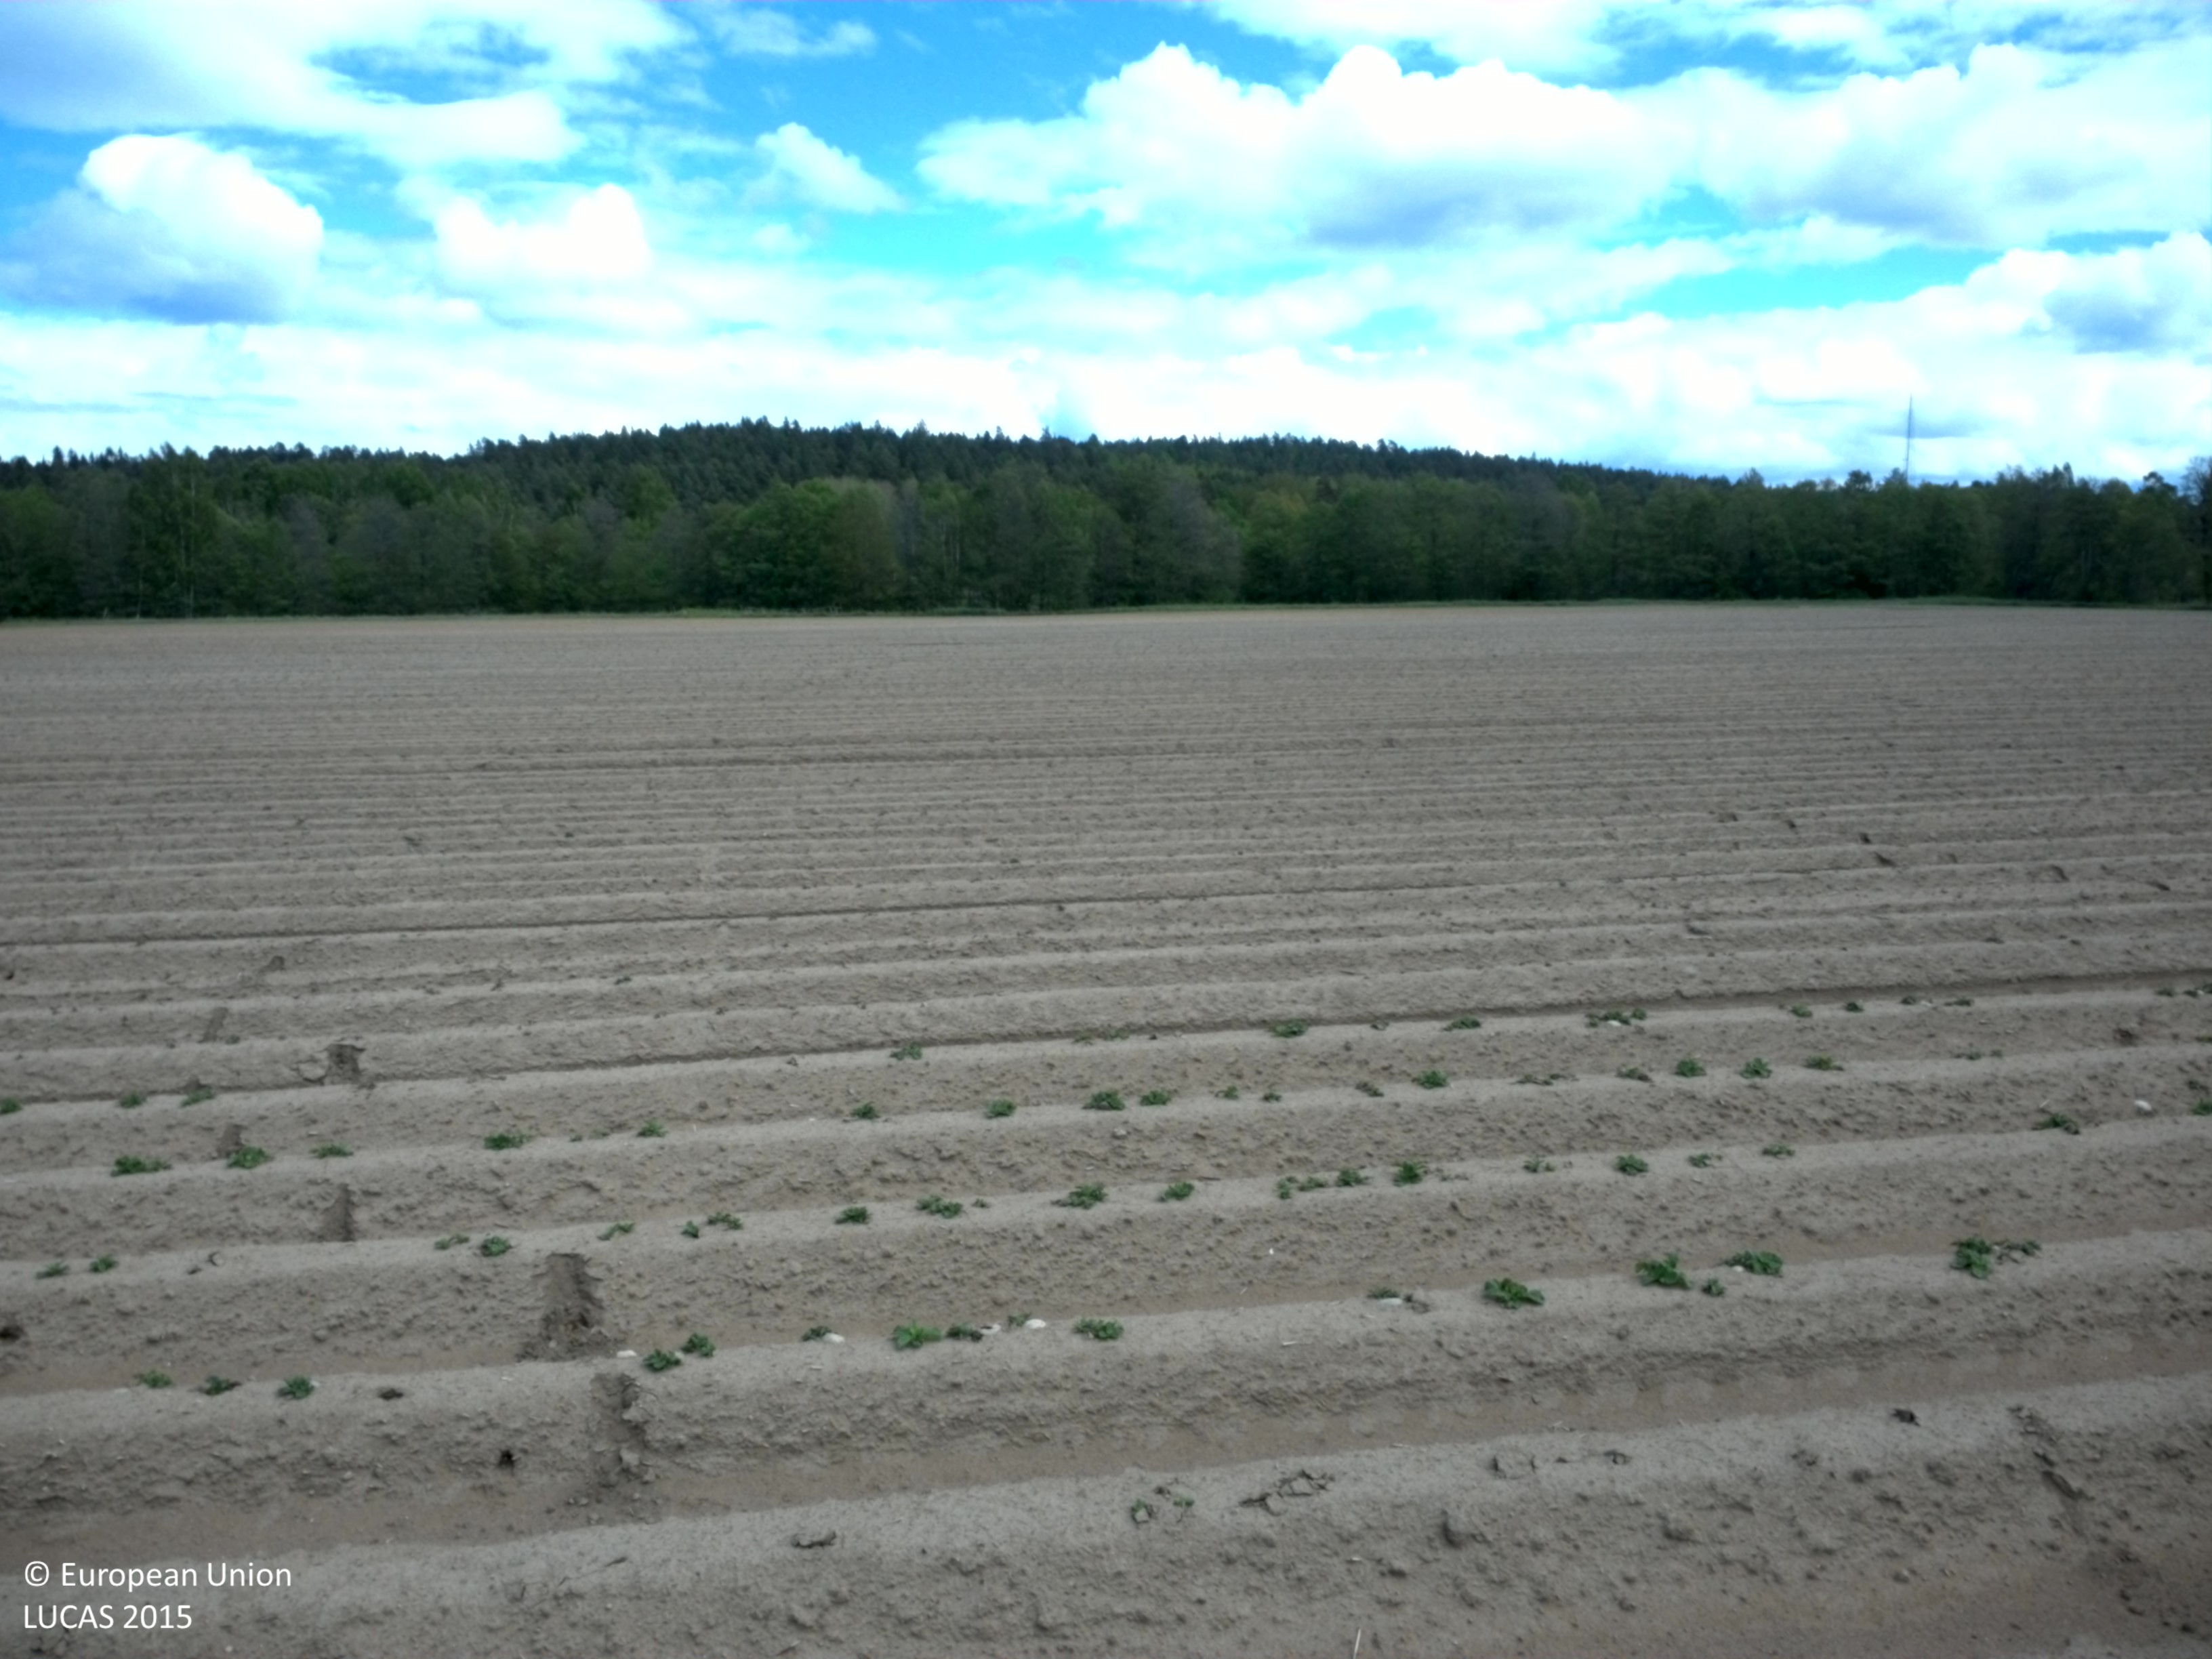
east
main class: Cropland
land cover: Potatoes
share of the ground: < 10 %
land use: Agriculture (excluding fallow land and kitchen gardens)
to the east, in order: Potatoes; Other bare soil; Grassland without tree/shrub cover; Broadleaved woodland; Inland fresh running water; Inland marshes; Broadleaved woodland; Inland marshes; Inland fresh running water
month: May
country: SE
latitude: 57.3714
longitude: 15.8345
